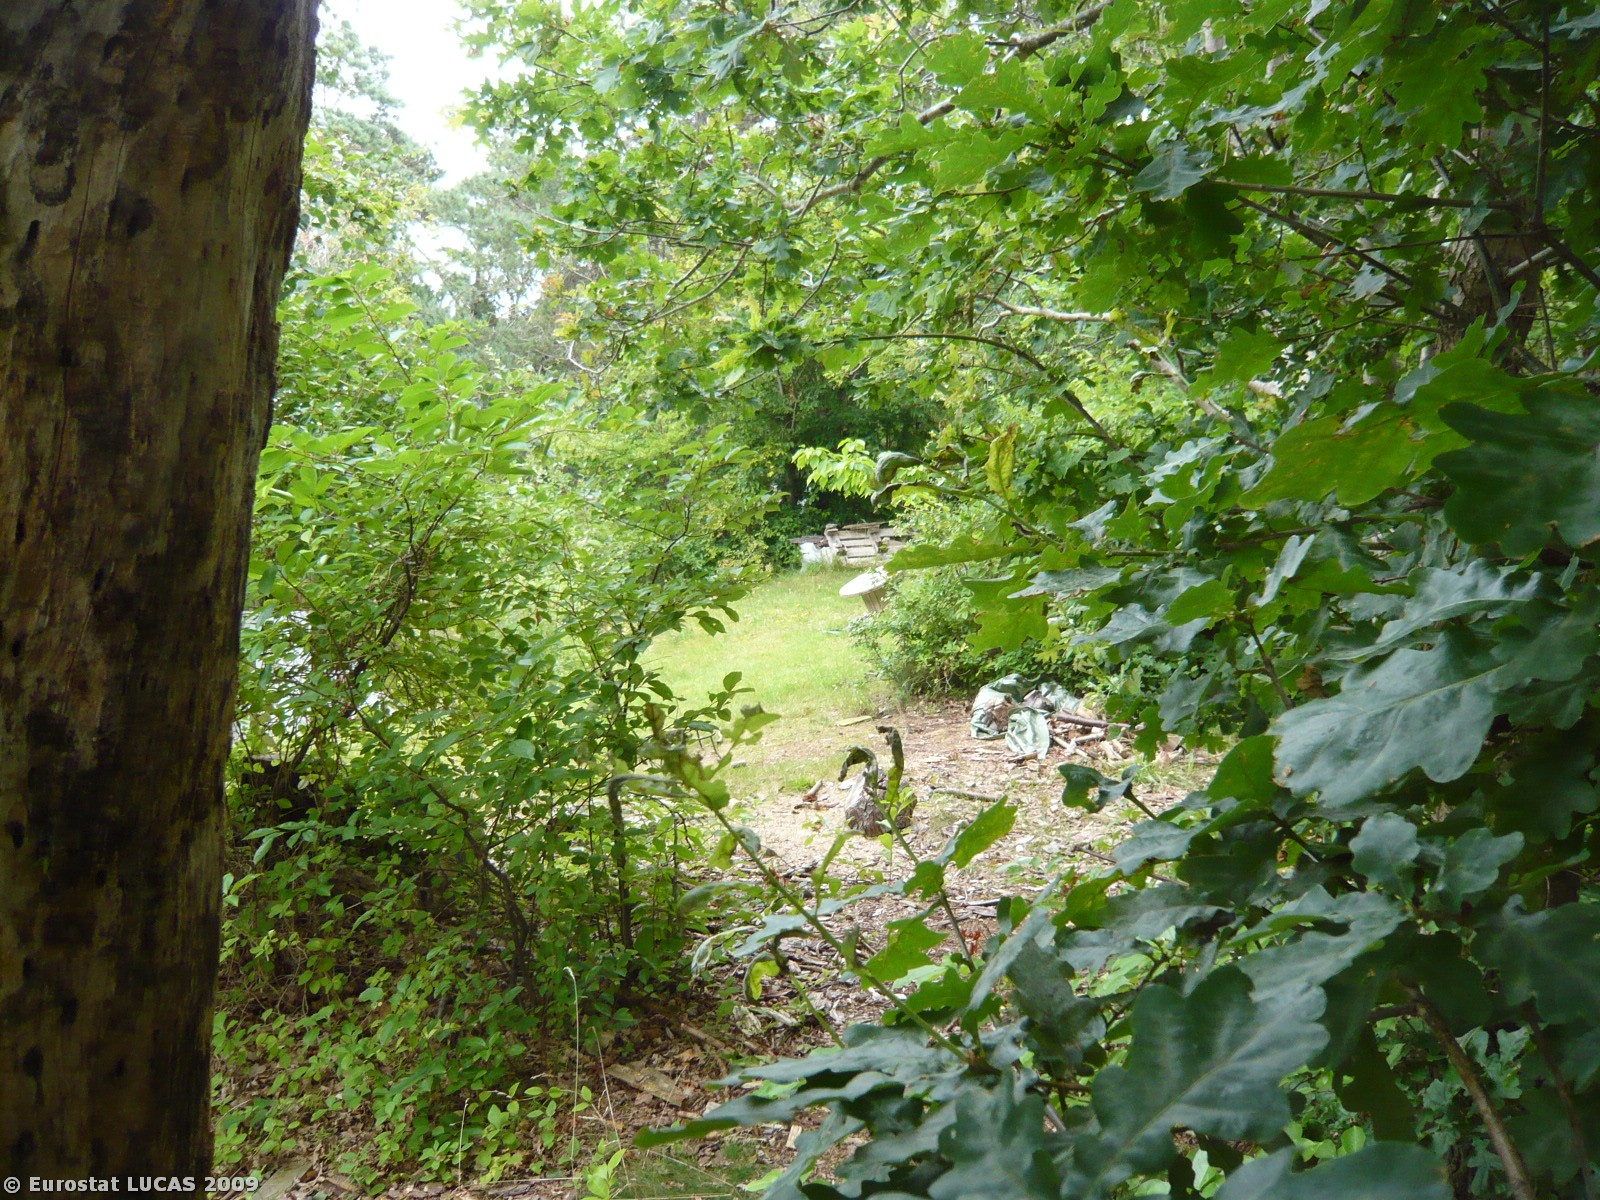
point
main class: Woodland
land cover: Broadleaved woodland
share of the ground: > 75 %
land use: Residential
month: August
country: DK
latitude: 56.0975
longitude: 12.1680
